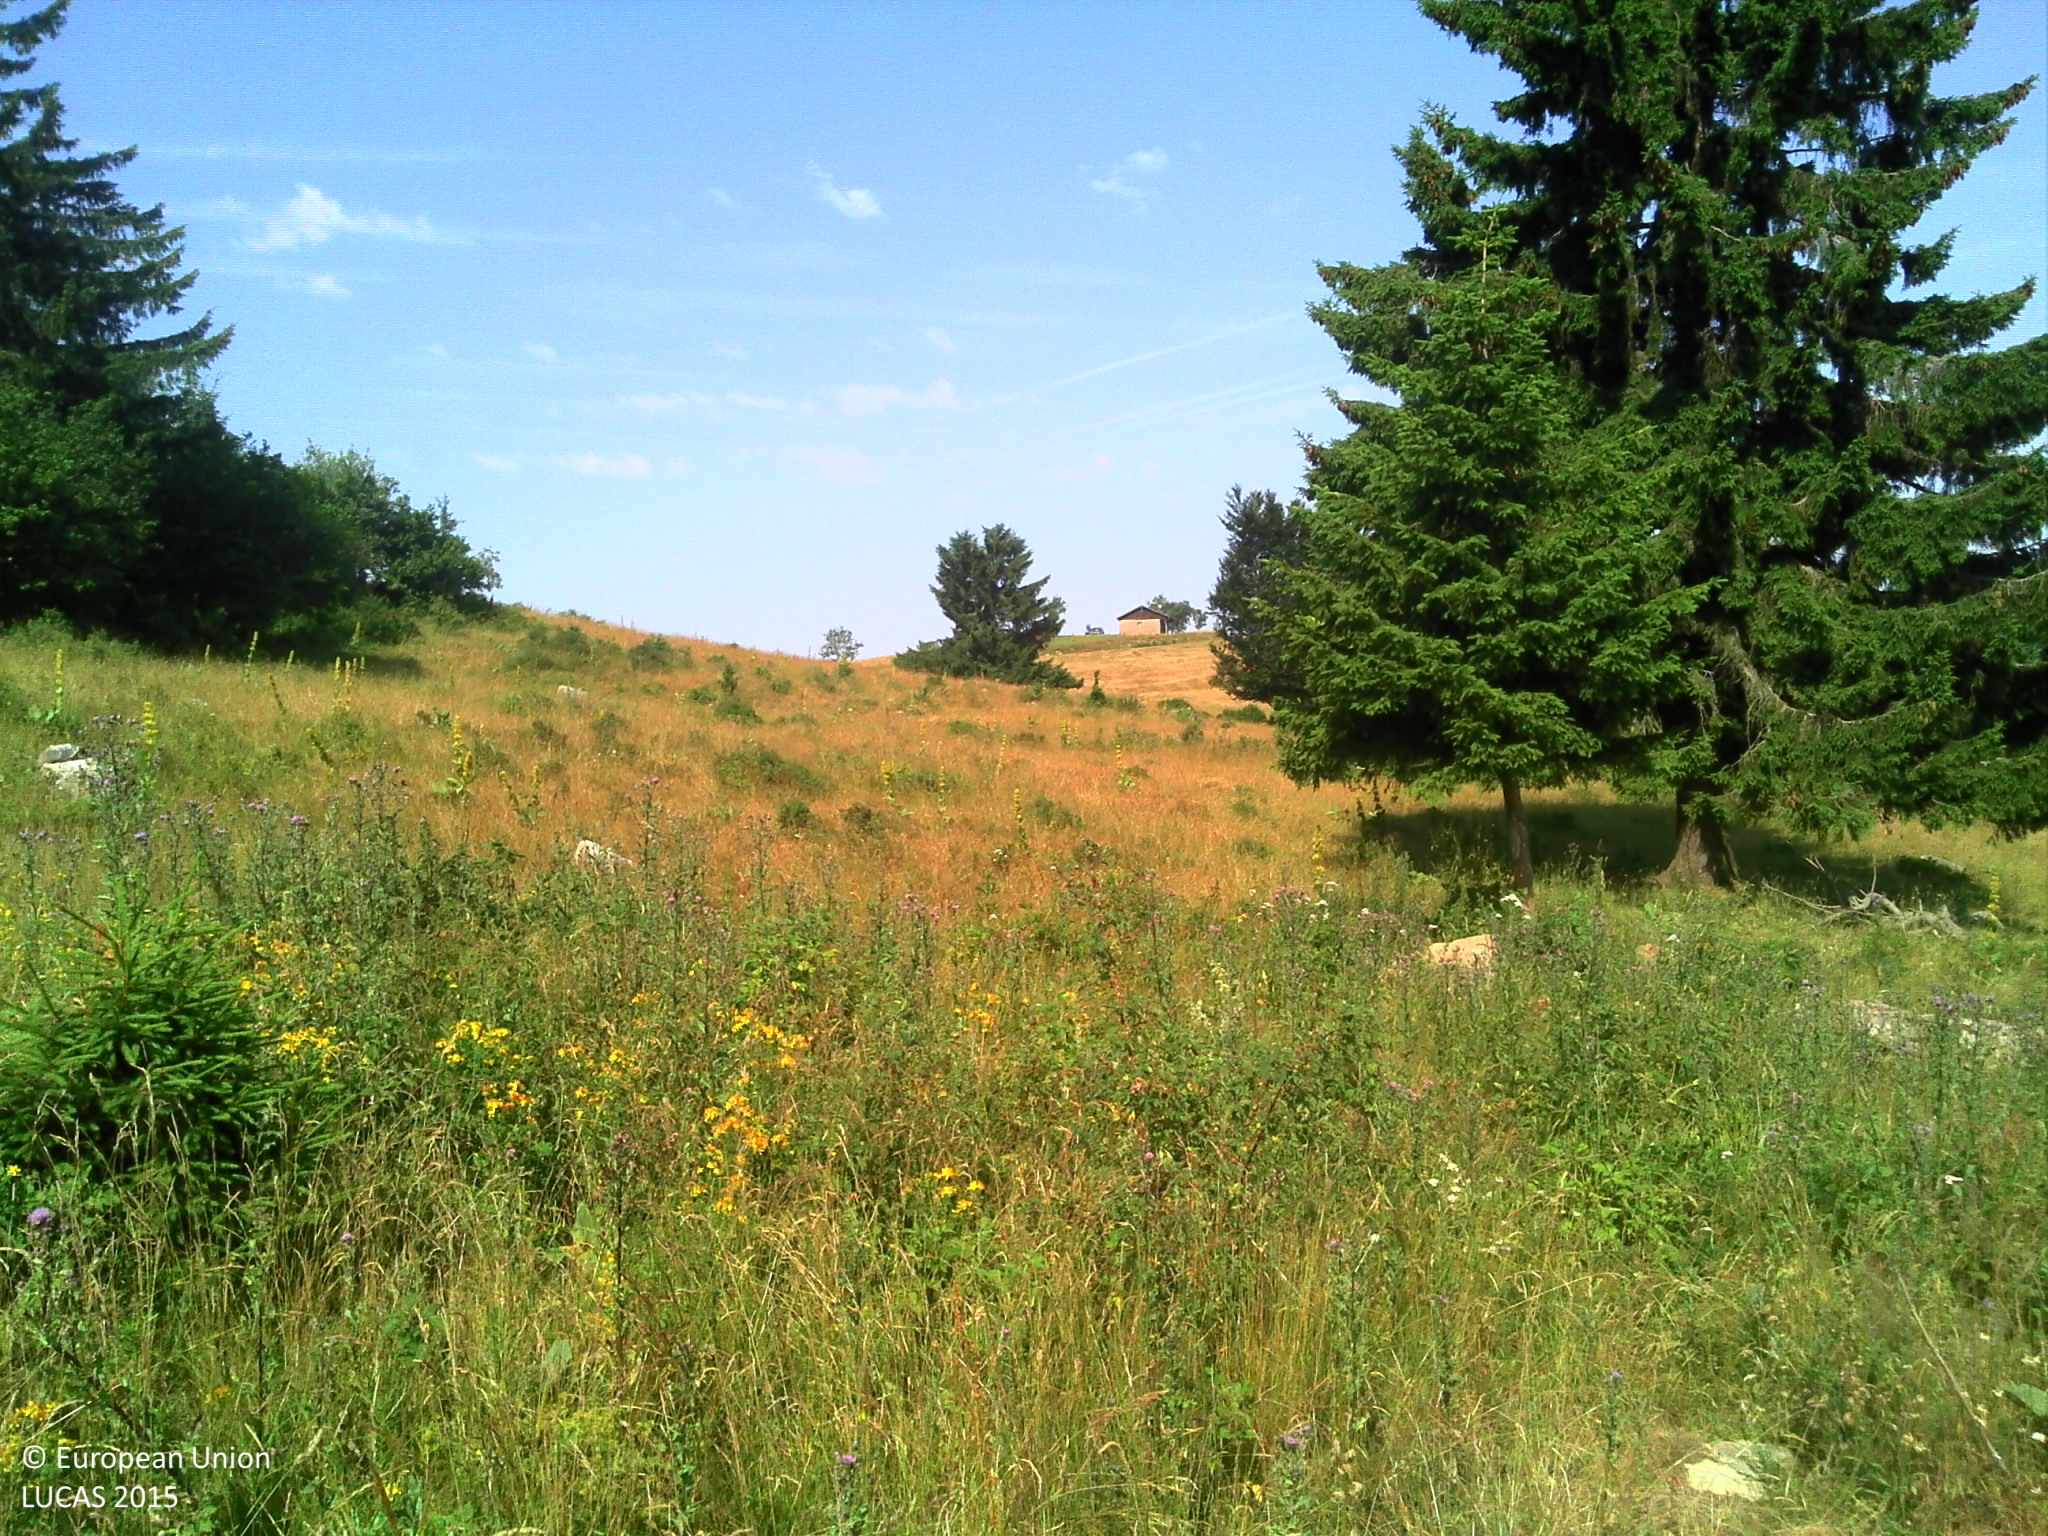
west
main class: Grassland
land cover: Grassland with sparse tree/shrub cover
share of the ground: > 75 %
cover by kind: herbaceous plants 90 %, coniferous forest trees 5 %, shrubs 5 %
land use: Agriculture (excluding fallow land and kitchen gardens)
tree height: < 5 m
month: July
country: FR
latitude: 46.1389
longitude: 6.1848
